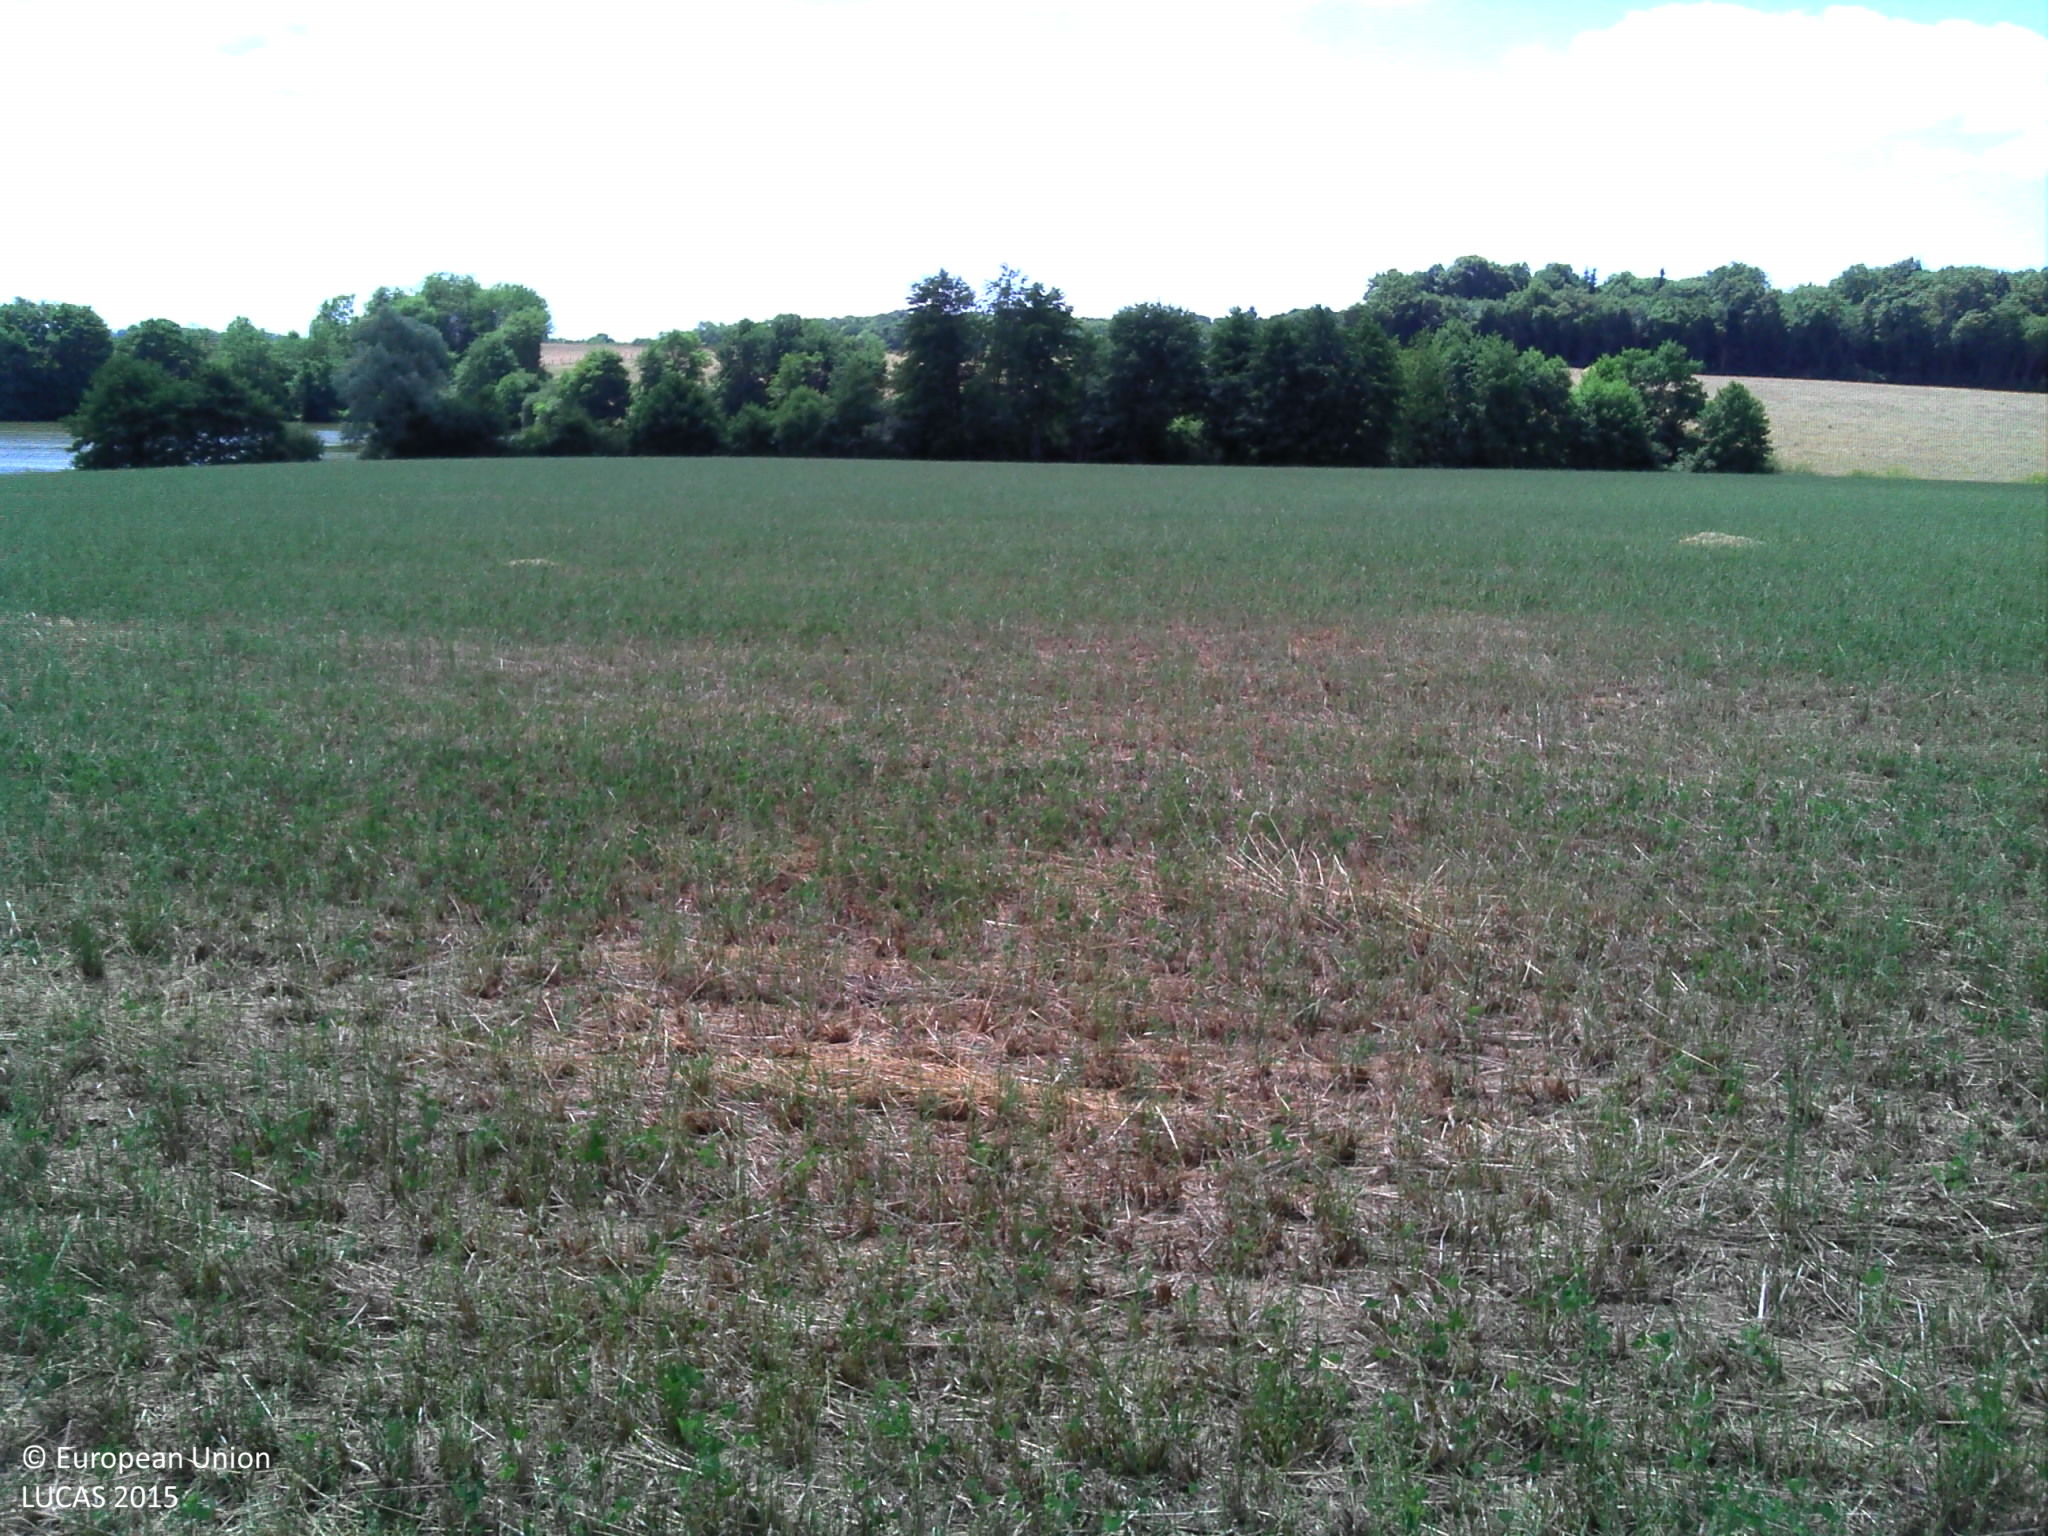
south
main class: Cropland
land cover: Mixed cereals for fodder
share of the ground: > 75 %
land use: Agriculture (excluding fallow land and kitchen gardens)
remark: Harvested field
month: July
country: FR
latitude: 46.9019
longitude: 3.6315
